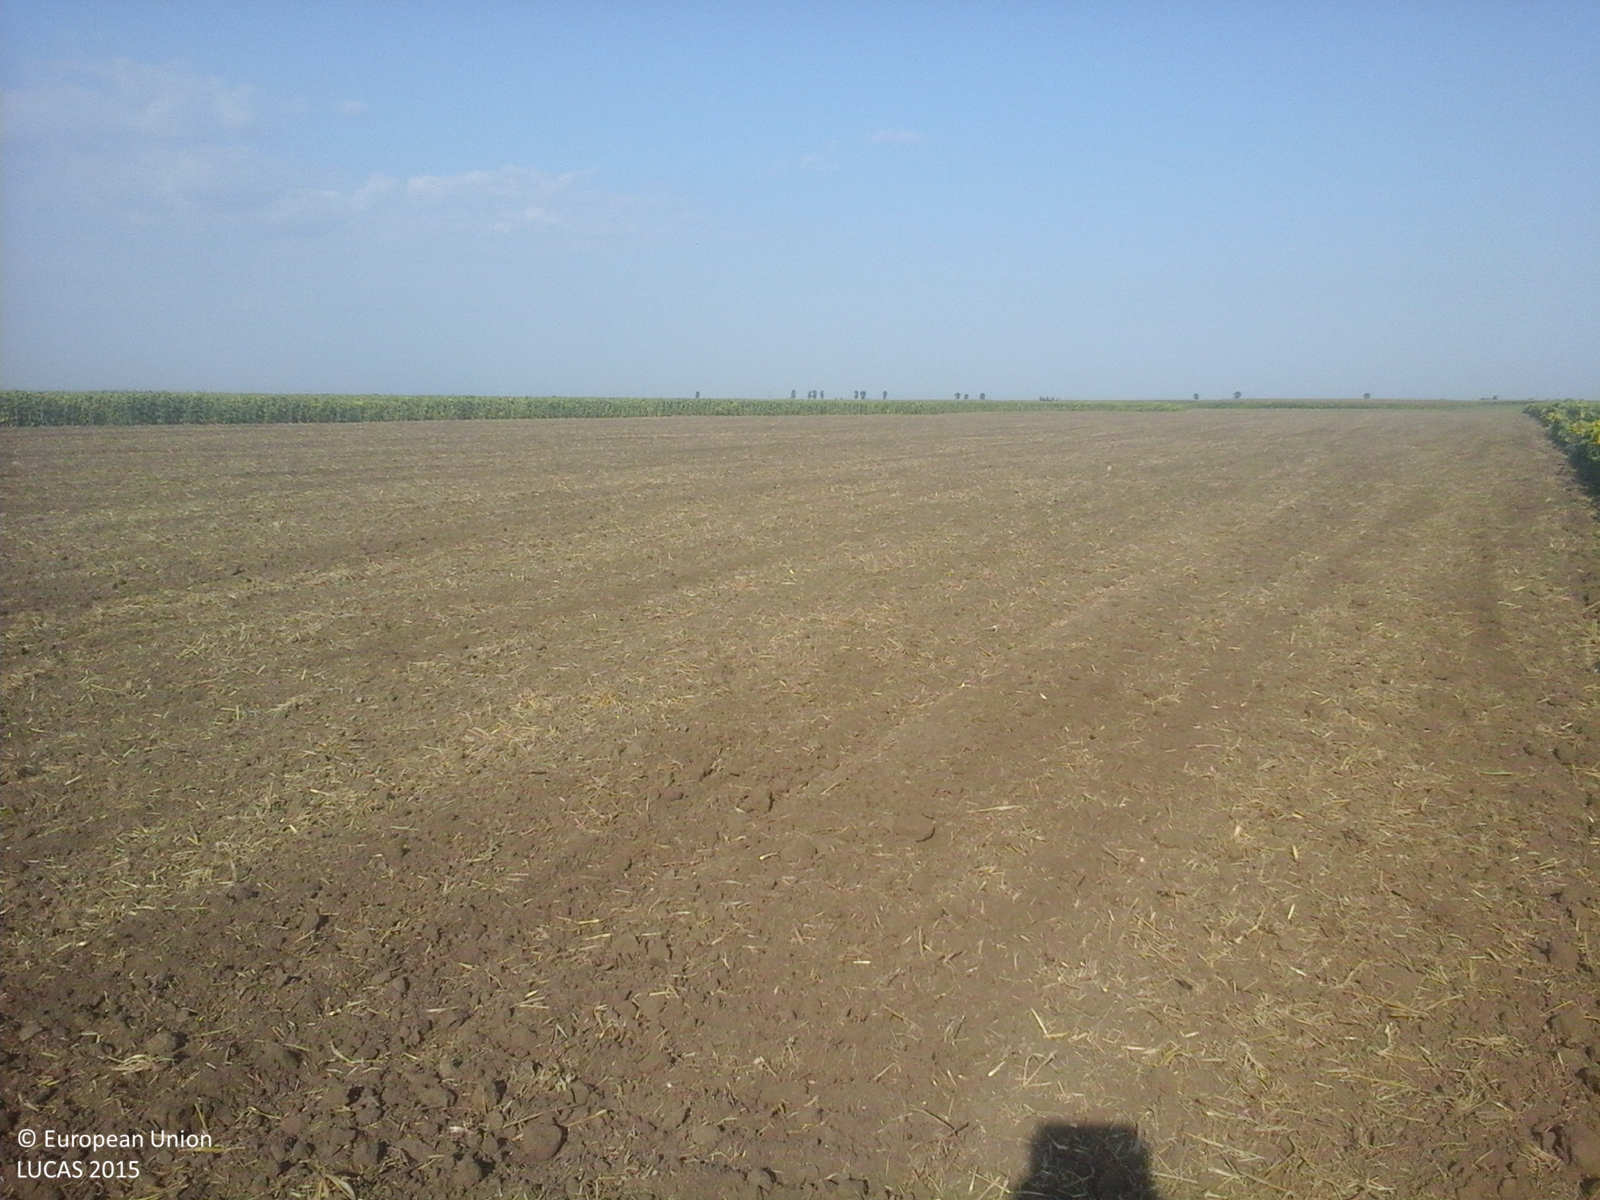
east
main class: Cropland
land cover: Sunflower
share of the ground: > 75 %
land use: Agriculture (excluding fallow land and kitchen gardens)
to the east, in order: Sunflower; Common wheat
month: July
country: RO
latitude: 44.9461
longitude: 27.7336
